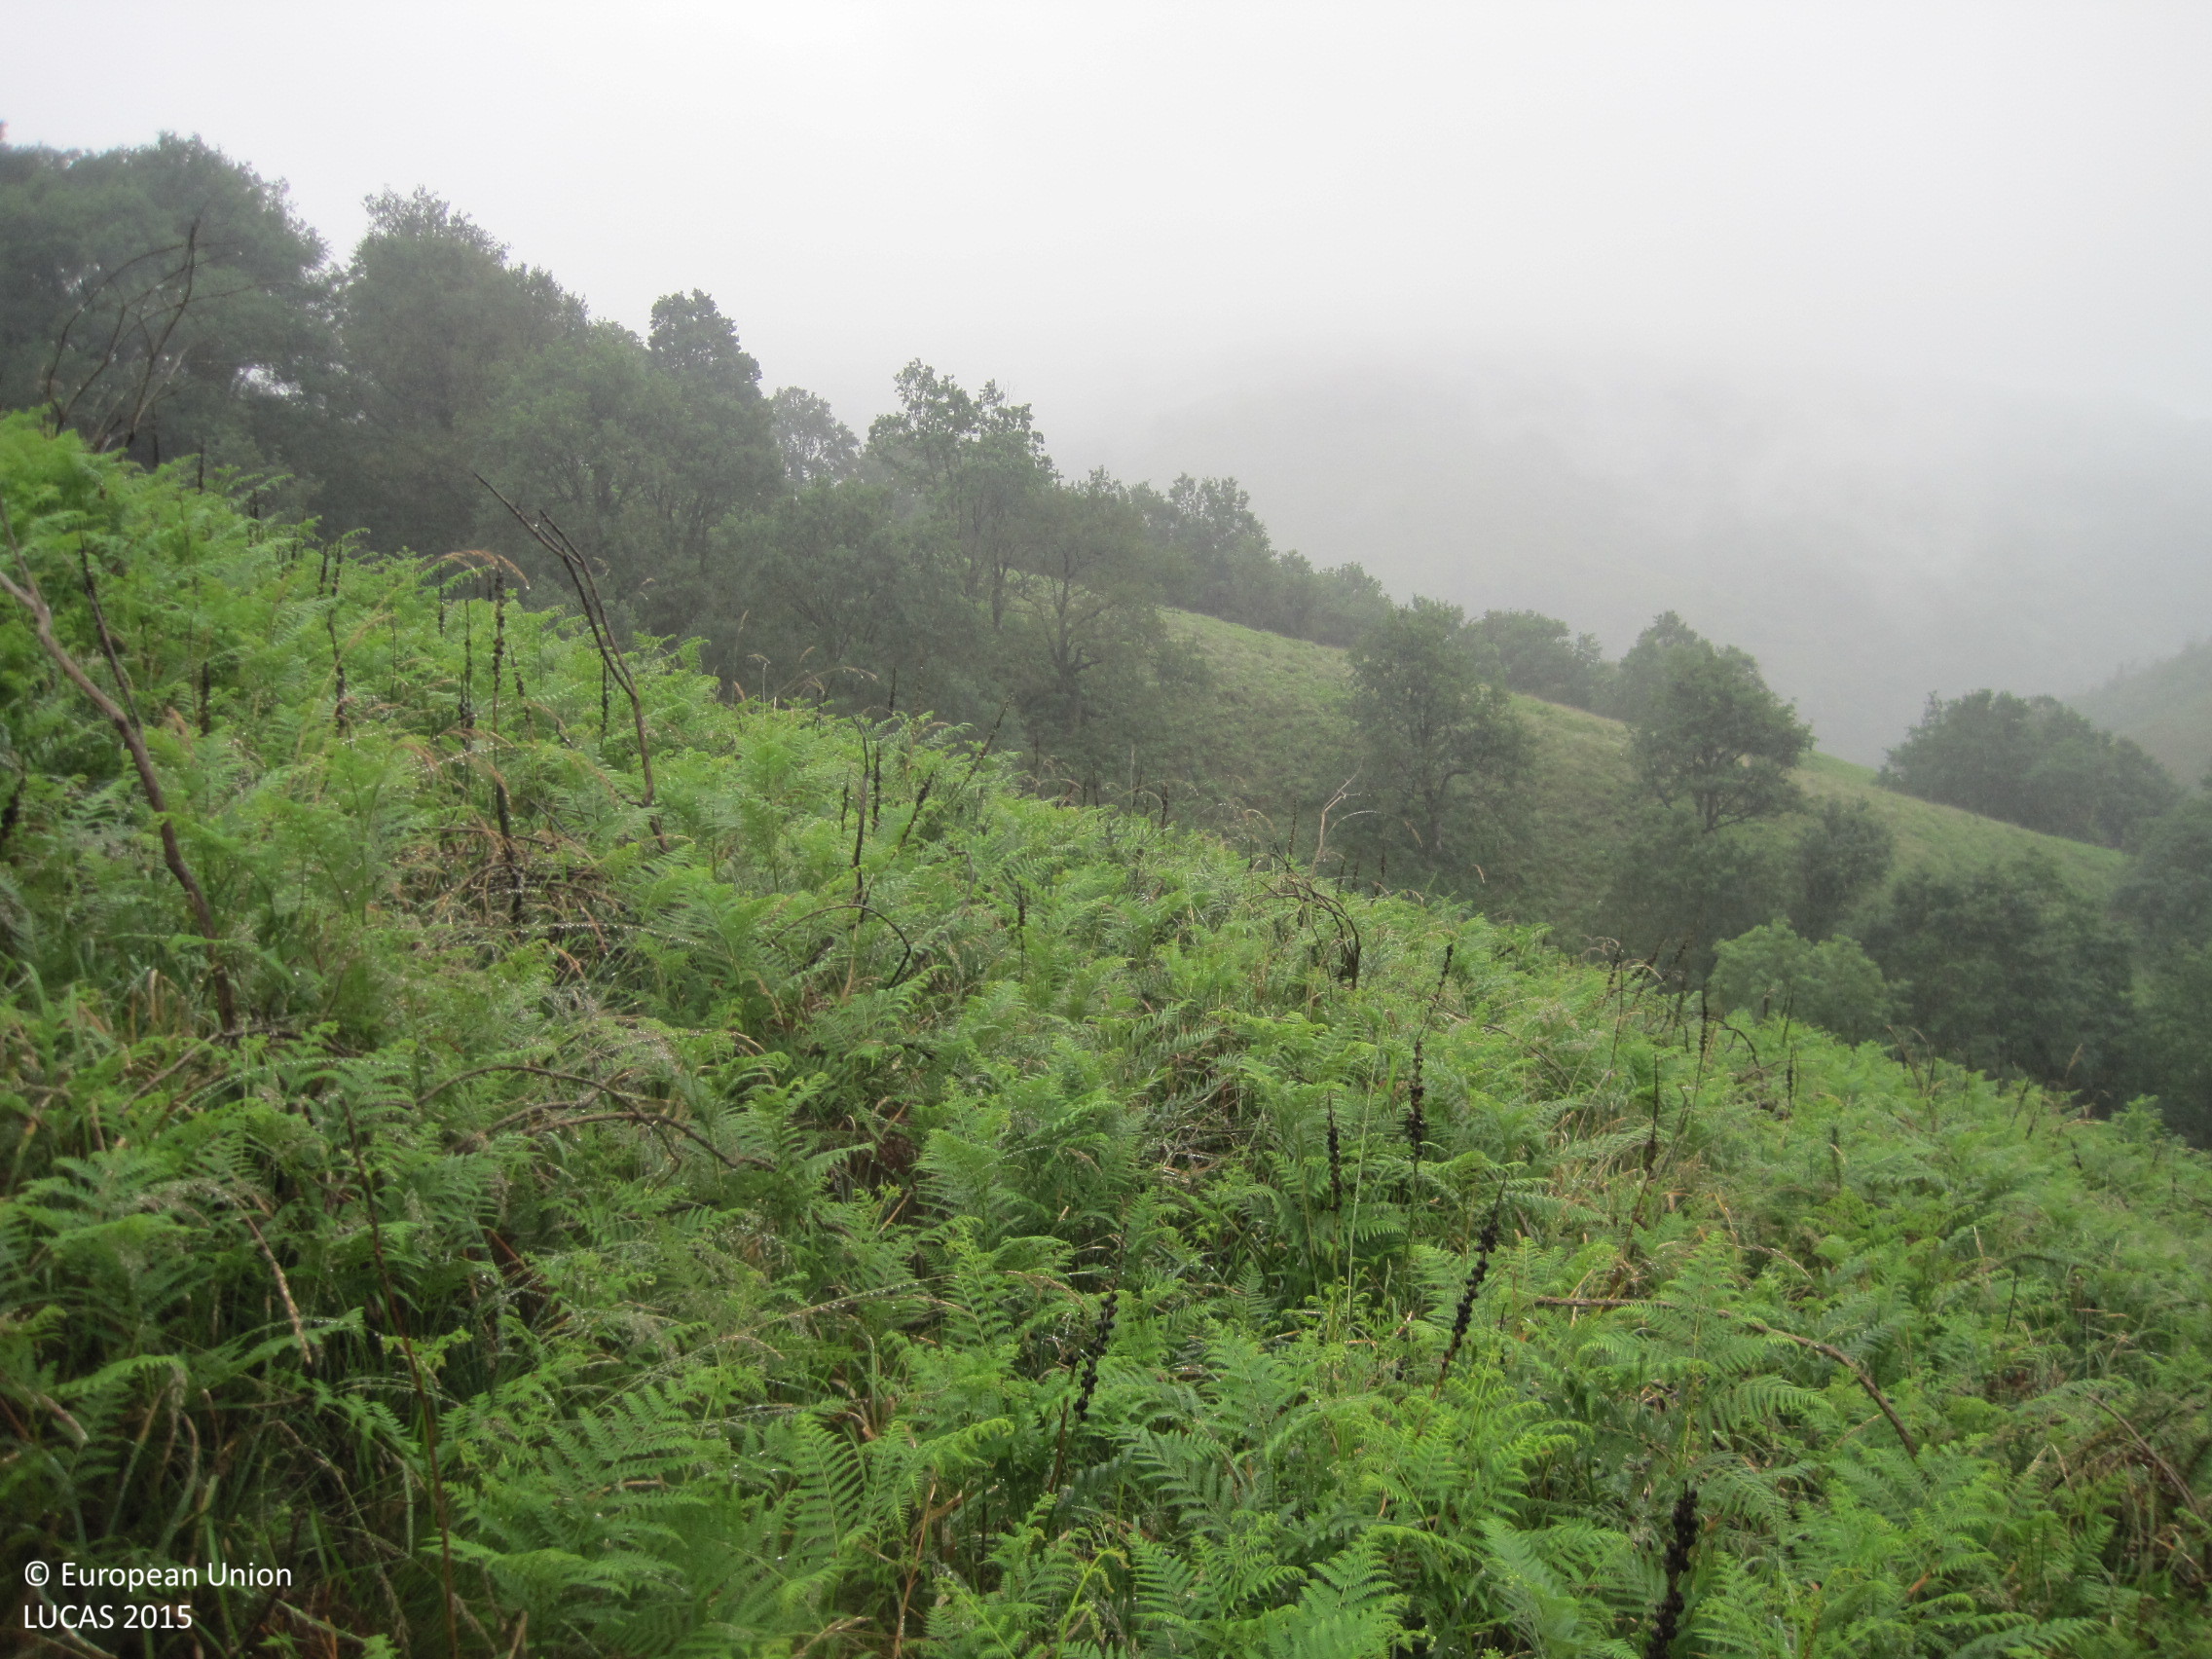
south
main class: Grassland
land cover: Grassland without tree/shrub cover
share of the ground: > 75 %
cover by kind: herbaceous plants 100 %
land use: Agriculture (excluding fallow land and kitchen gardens)
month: June
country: ES
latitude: 43.1958
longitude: -1.8459
